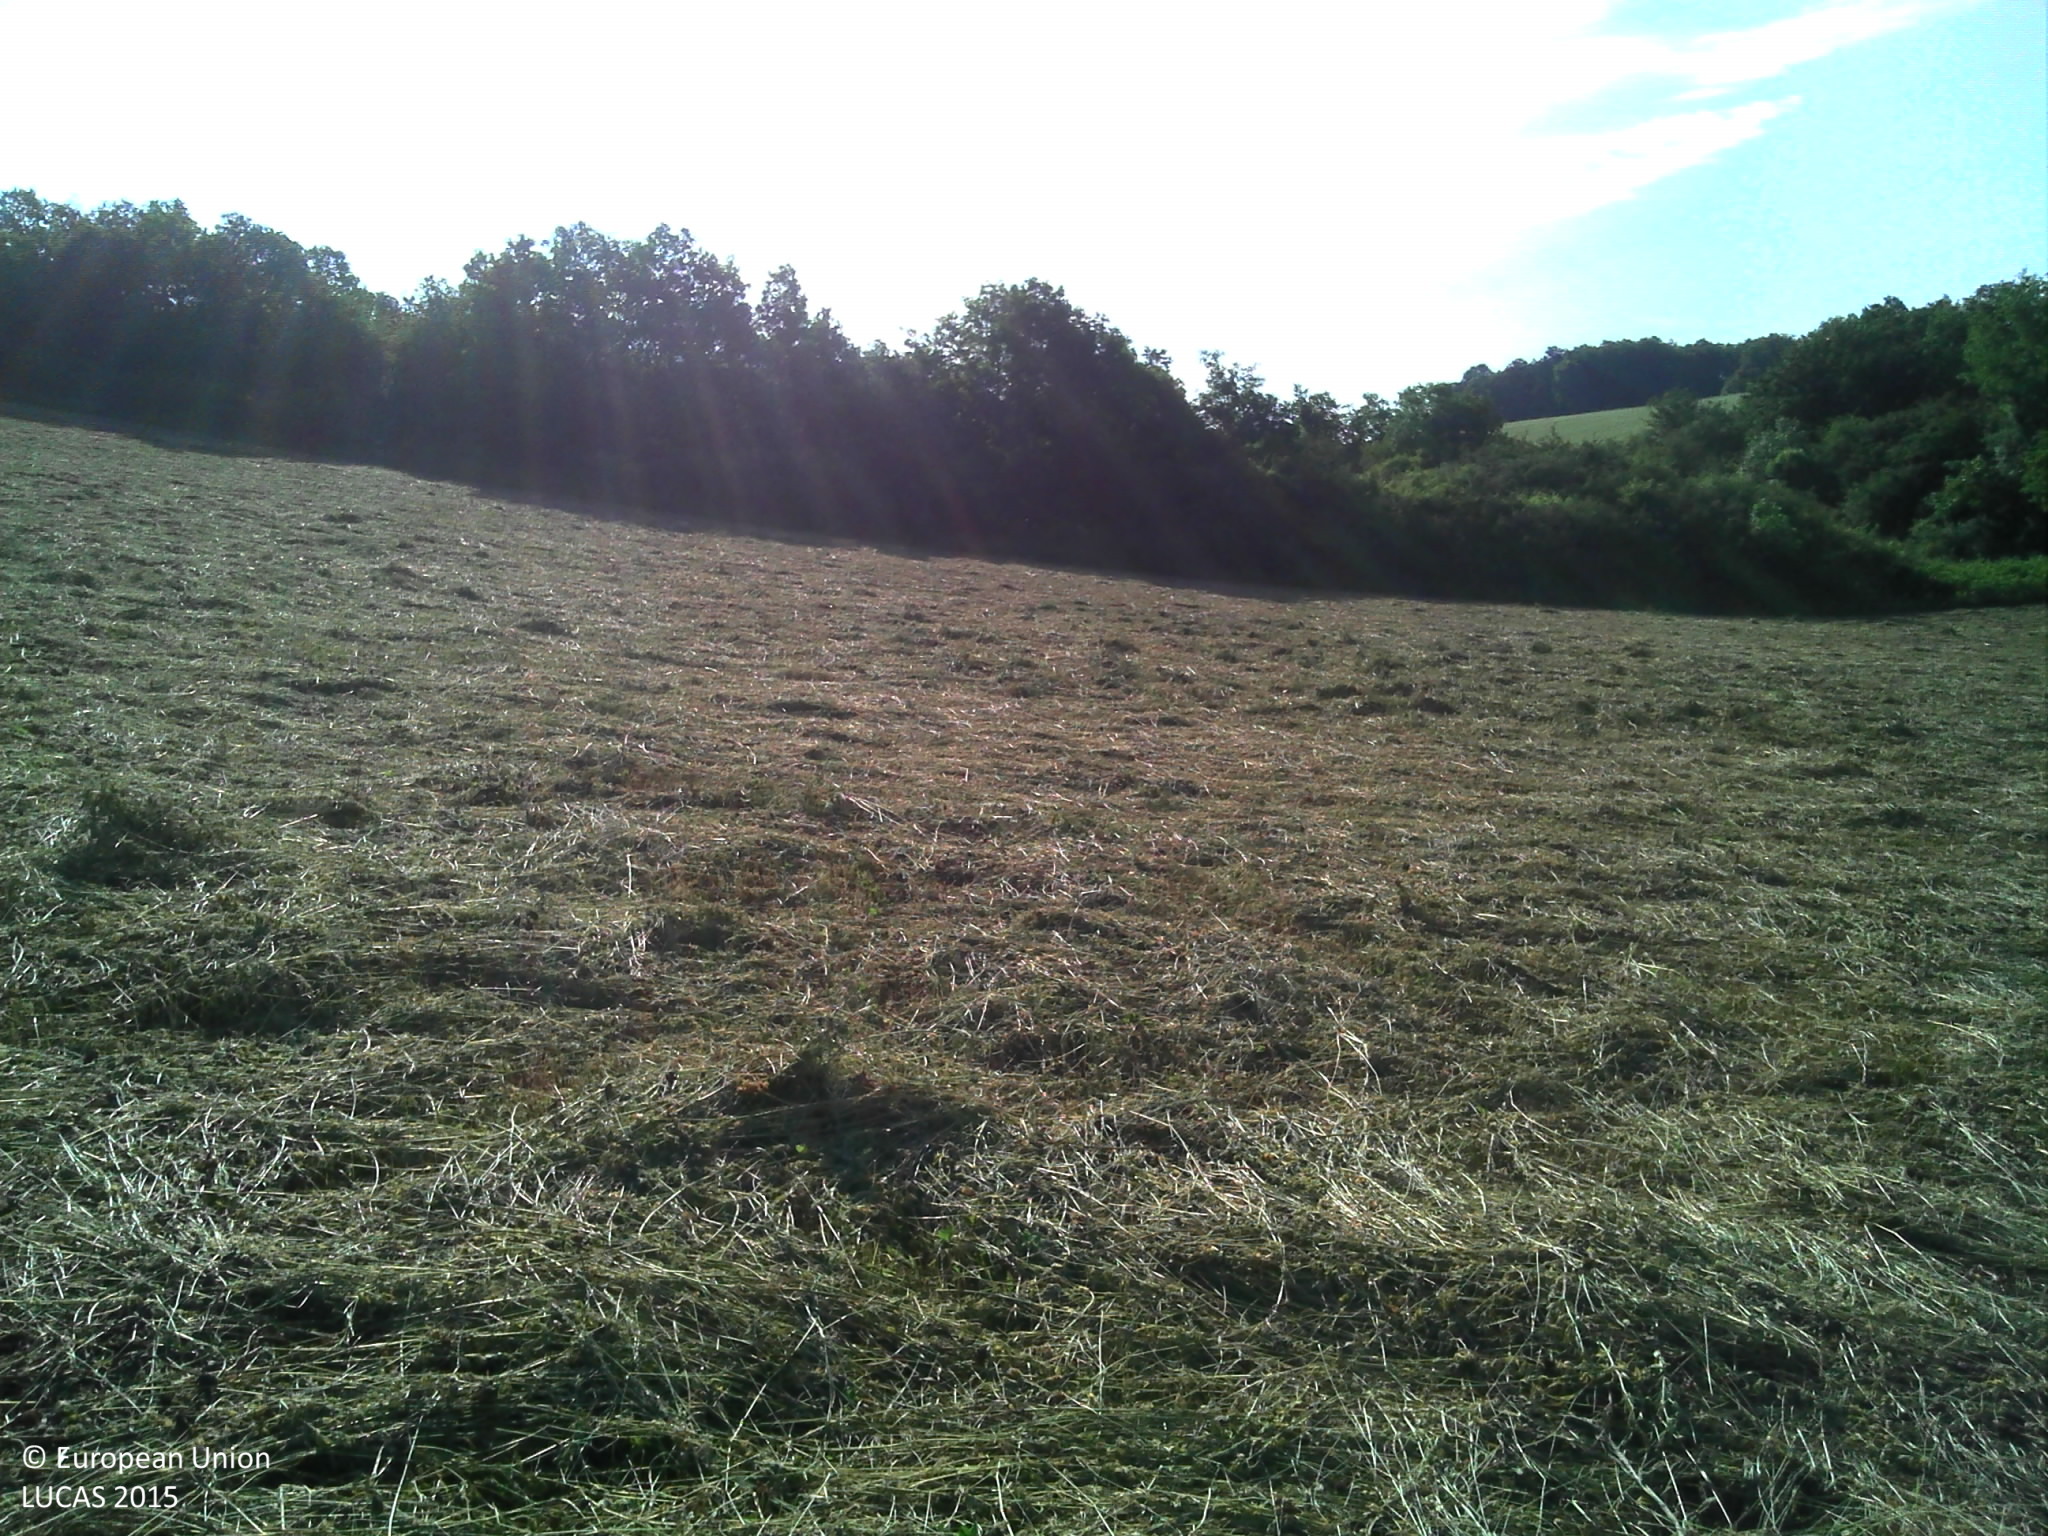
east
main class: Cropland
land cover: Other leguminous and mixtures for fodder
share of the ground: > 75 %
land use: Agriculture (excluding fallow land and kitchen gardens)
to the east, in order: Other leguminous and mixtures for fodder; Broadleaved woodland; Fences; Broadleaved woodland; Fences; Common wheat
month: June
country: FR
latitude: 47.6553
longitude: 3.8591
